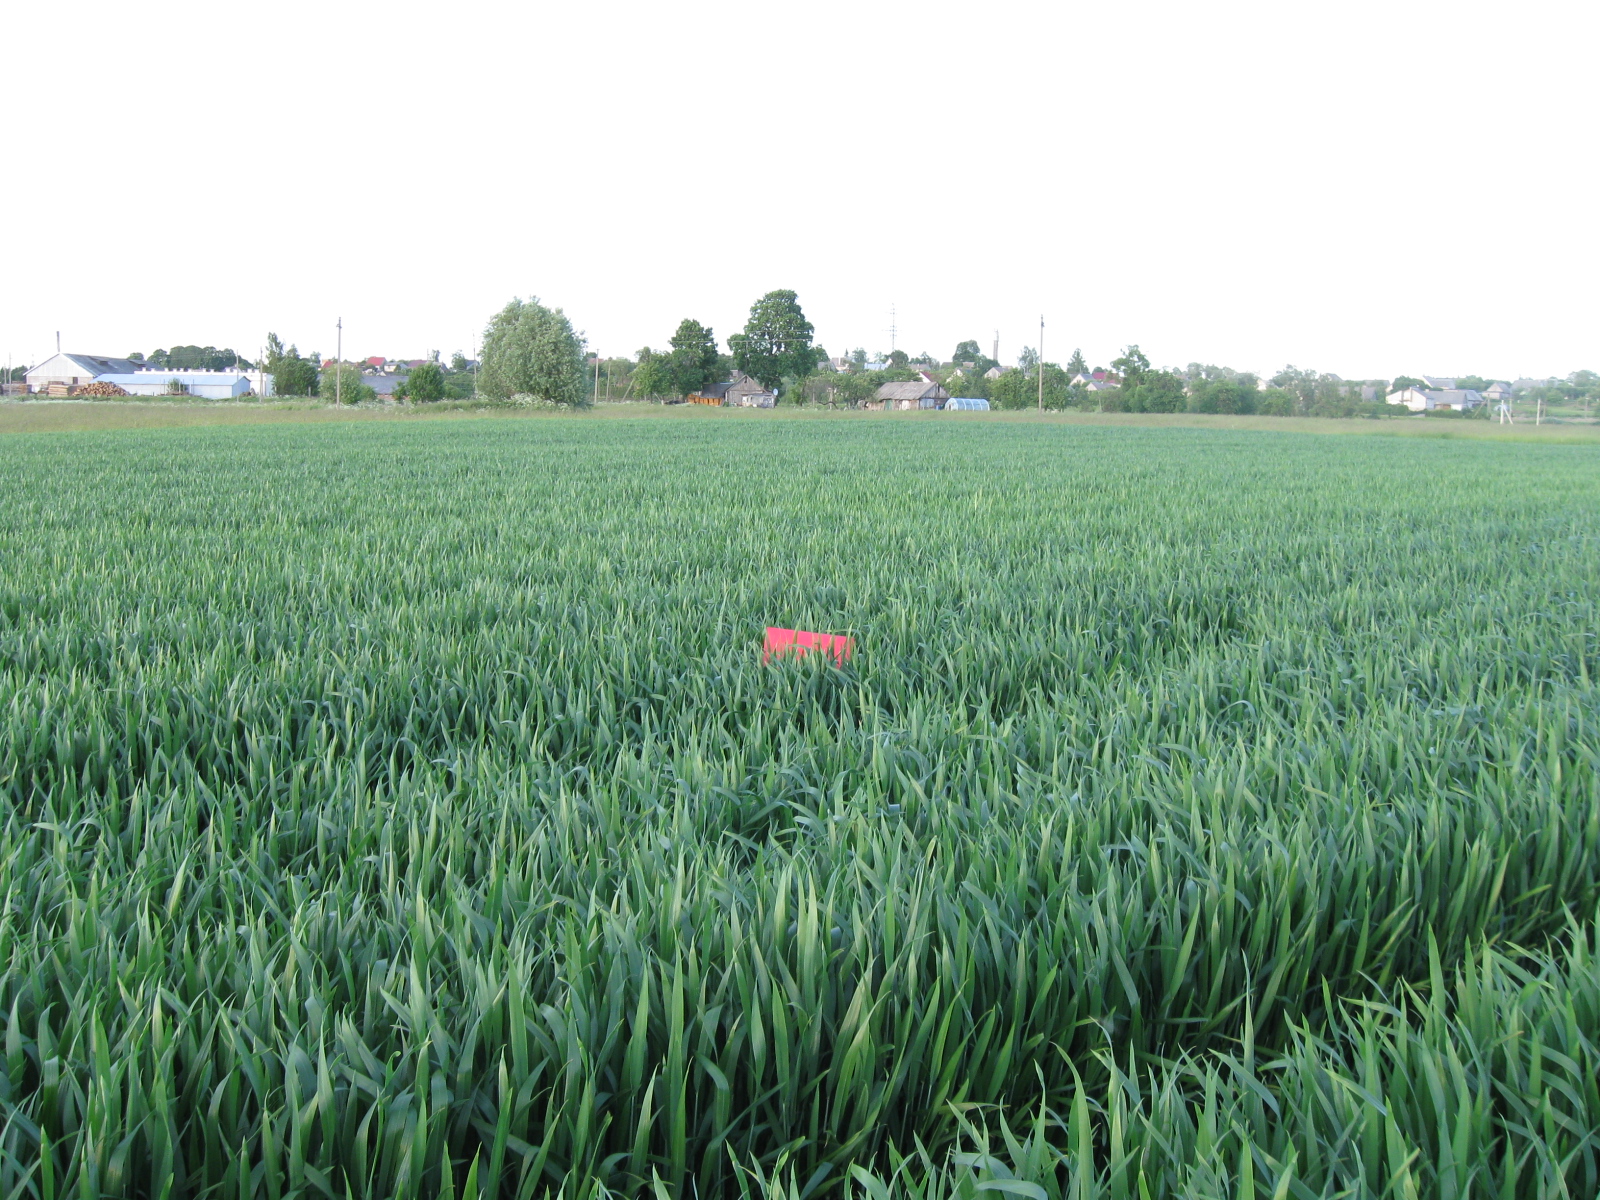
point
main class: Cropland
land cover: Common wheat
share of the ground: > 75 %
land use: Agriculture (excluding fallow land and kitchen gardens)
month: June
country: LT
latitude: 55.0384
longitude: 24.0977
